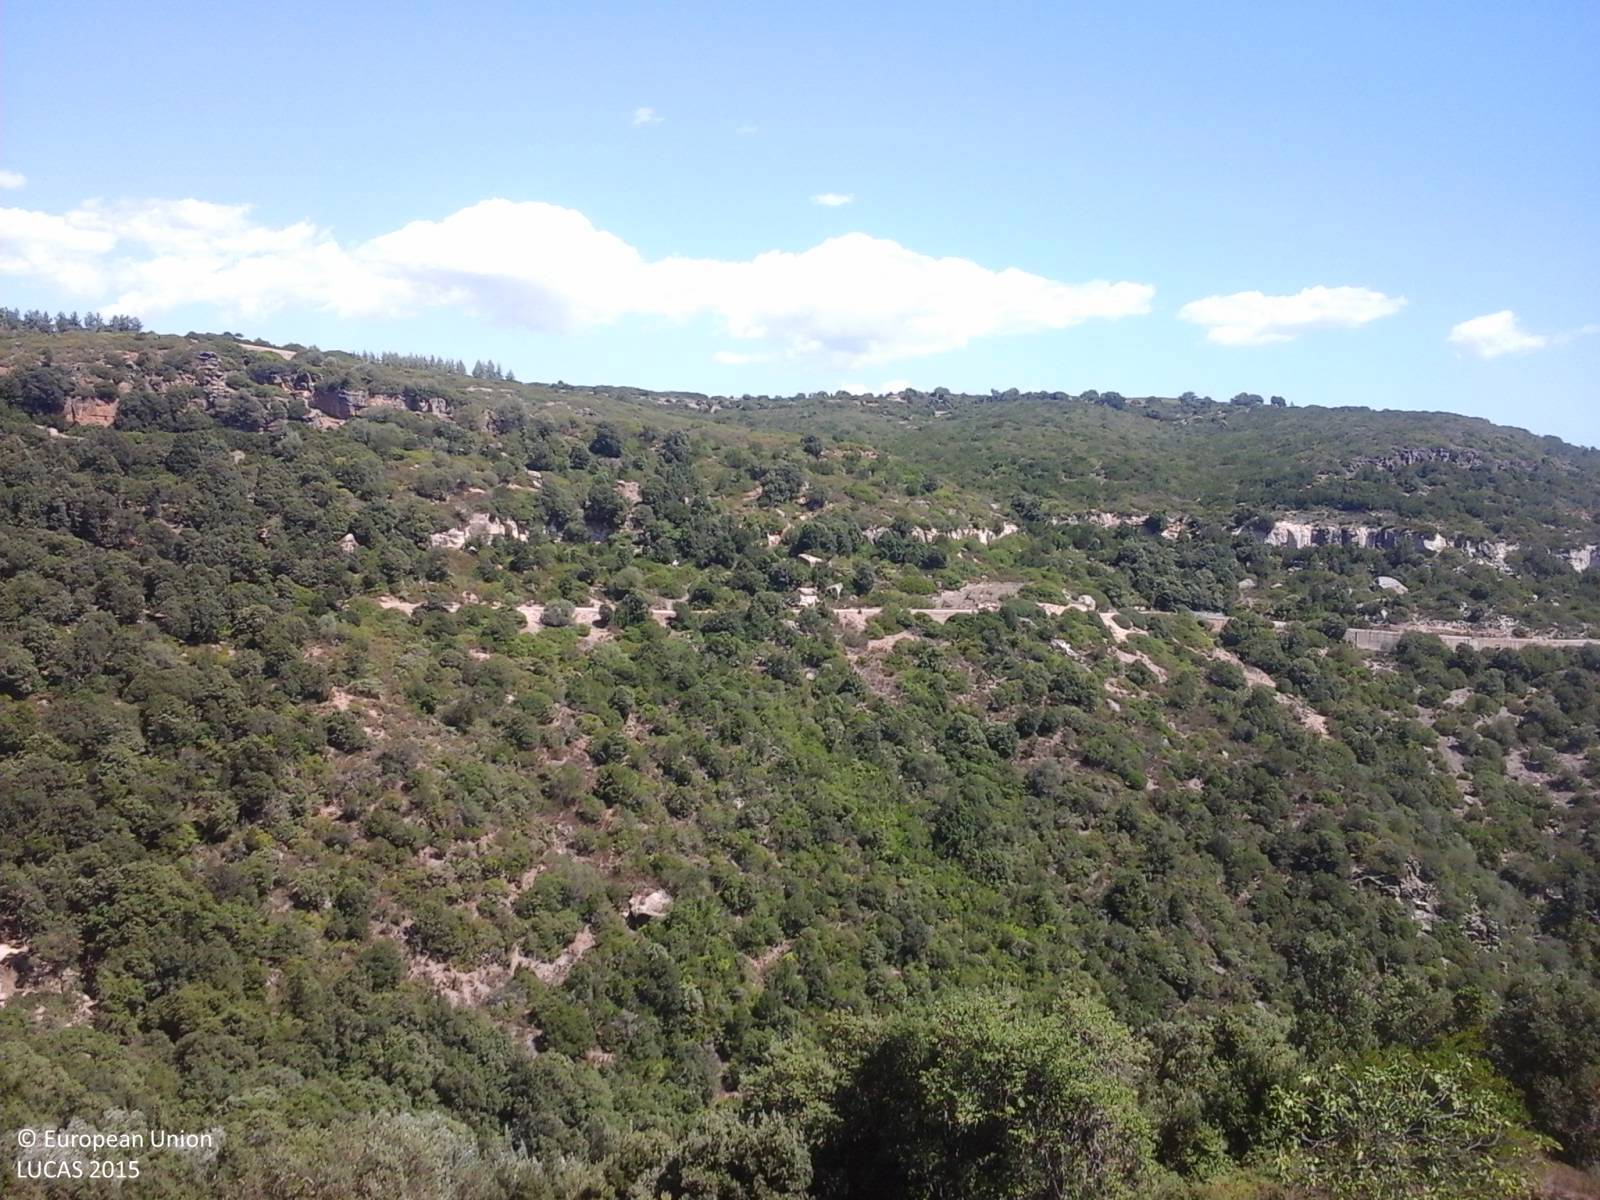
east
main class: Shrubland
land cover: Shrubland without tree cover
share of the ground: > 75 %
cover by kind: shrubs 100 %
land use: Semi-natural and natural areas not in use
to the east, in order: Grass margins; Shrubland without tree cover; Vineyards; Broadleaved woodland; Rivers and streams; Broadleaved woodland
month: August
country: IT
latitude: 39.6496
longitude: 9.3627
